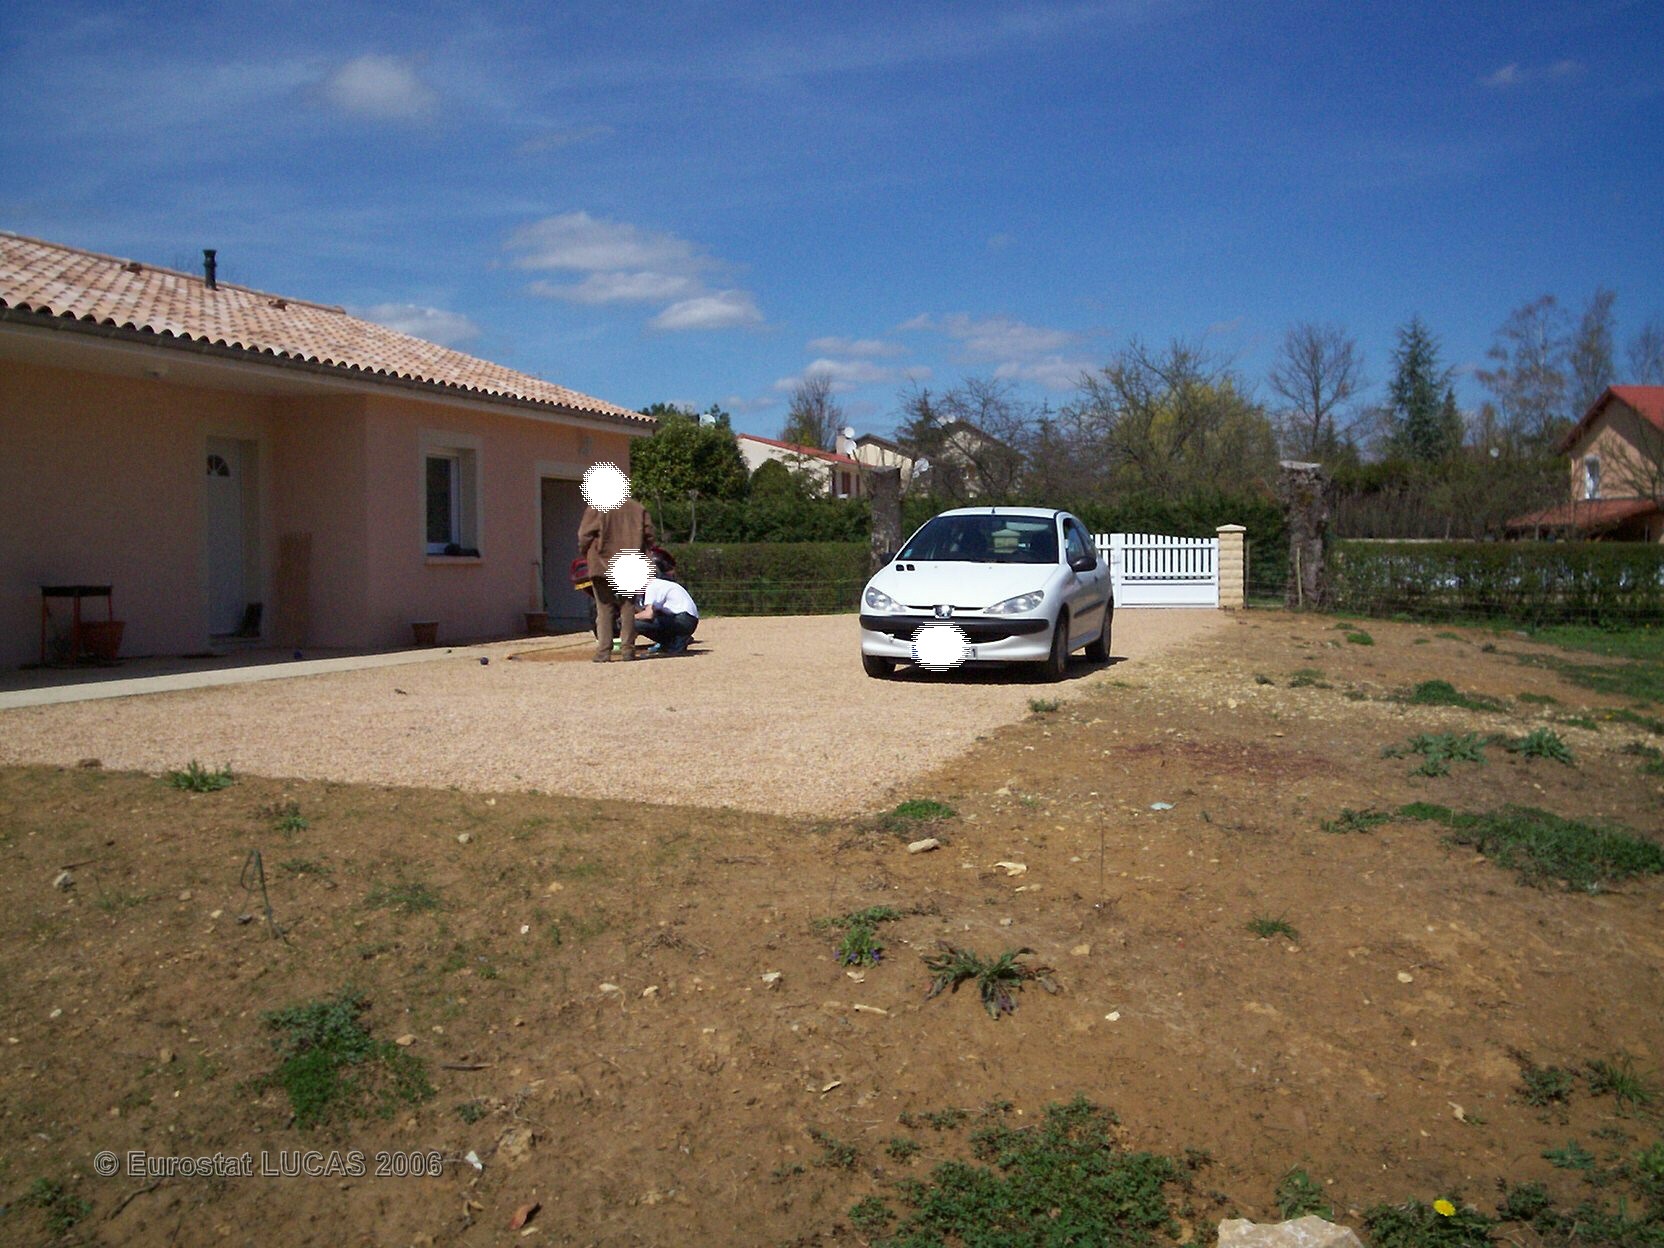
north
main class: Grassland
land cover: Grassland without tree/shrub cover
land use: Residential
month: April
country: FR
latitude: 46.4212
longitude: 4.7583
